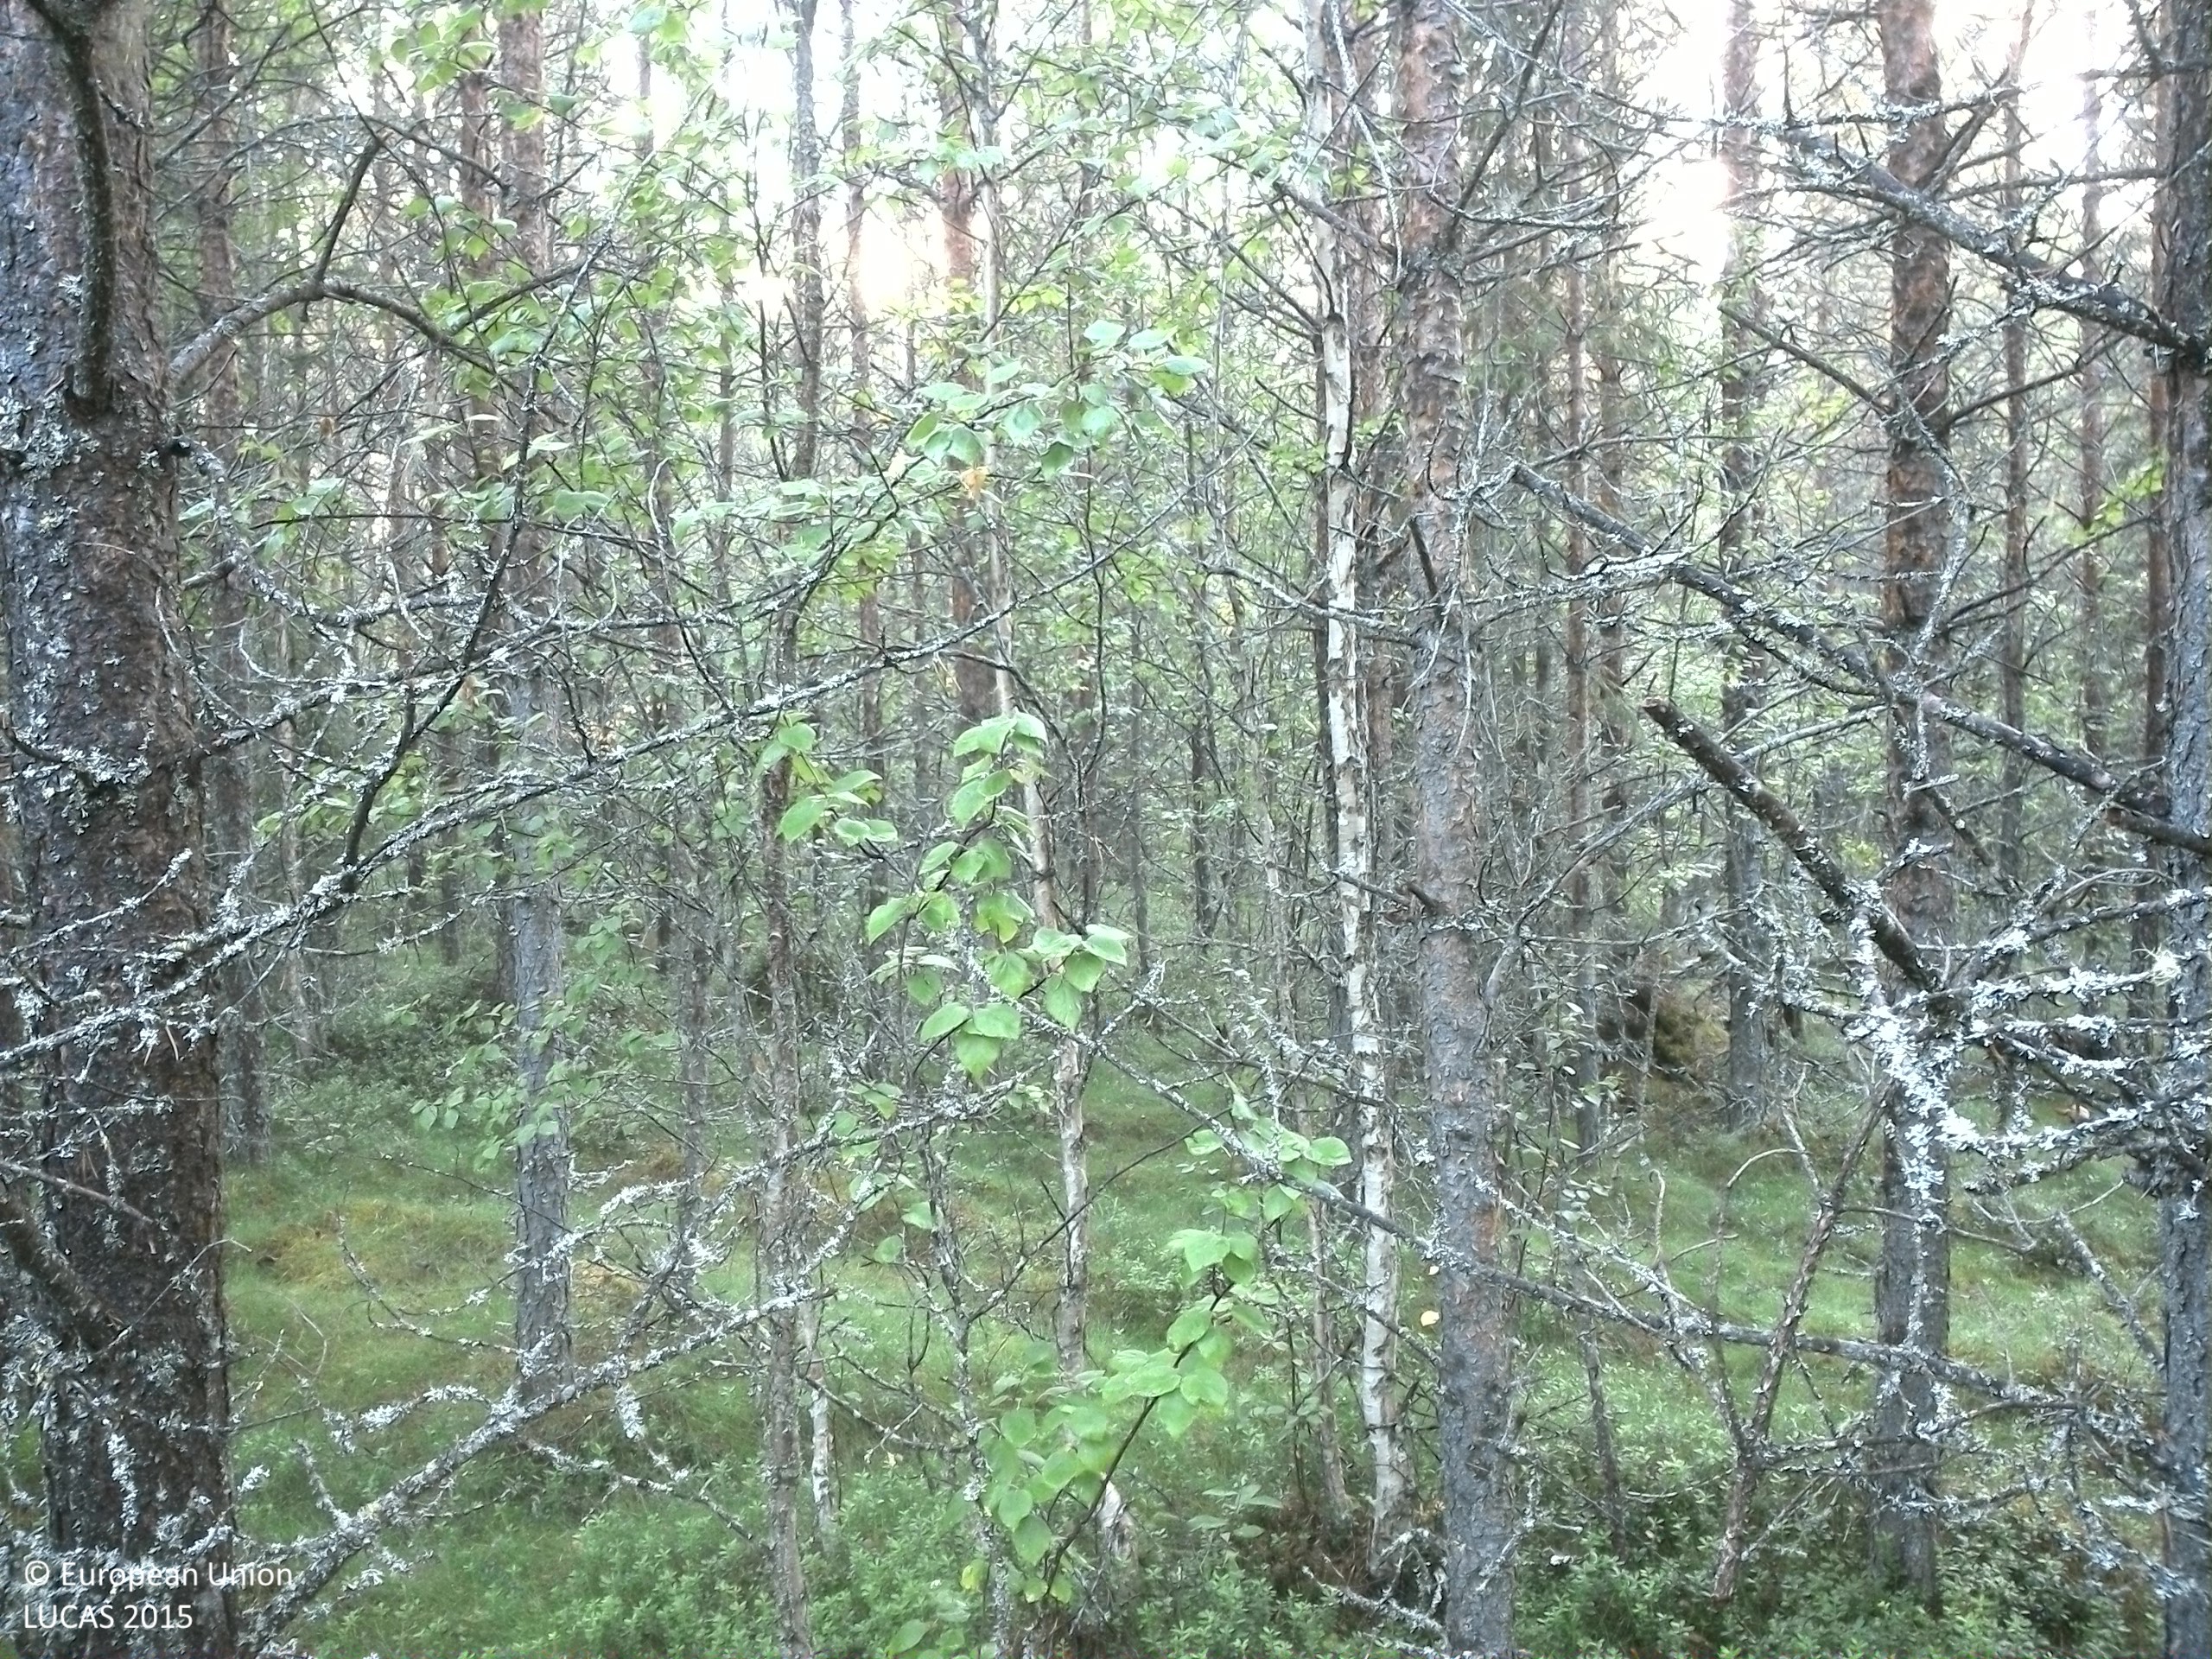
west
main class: Woodland
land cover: Pine dominated coniferous woodland
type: boreal forest
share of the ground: > 75 %
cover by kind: coniferous forest trees 80 %, shrubs 15 %, broadleaved forest trees 5 %
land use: Forestry
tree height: > 5 m
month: August
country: SE
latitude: 63.8665
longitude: 17.3174
